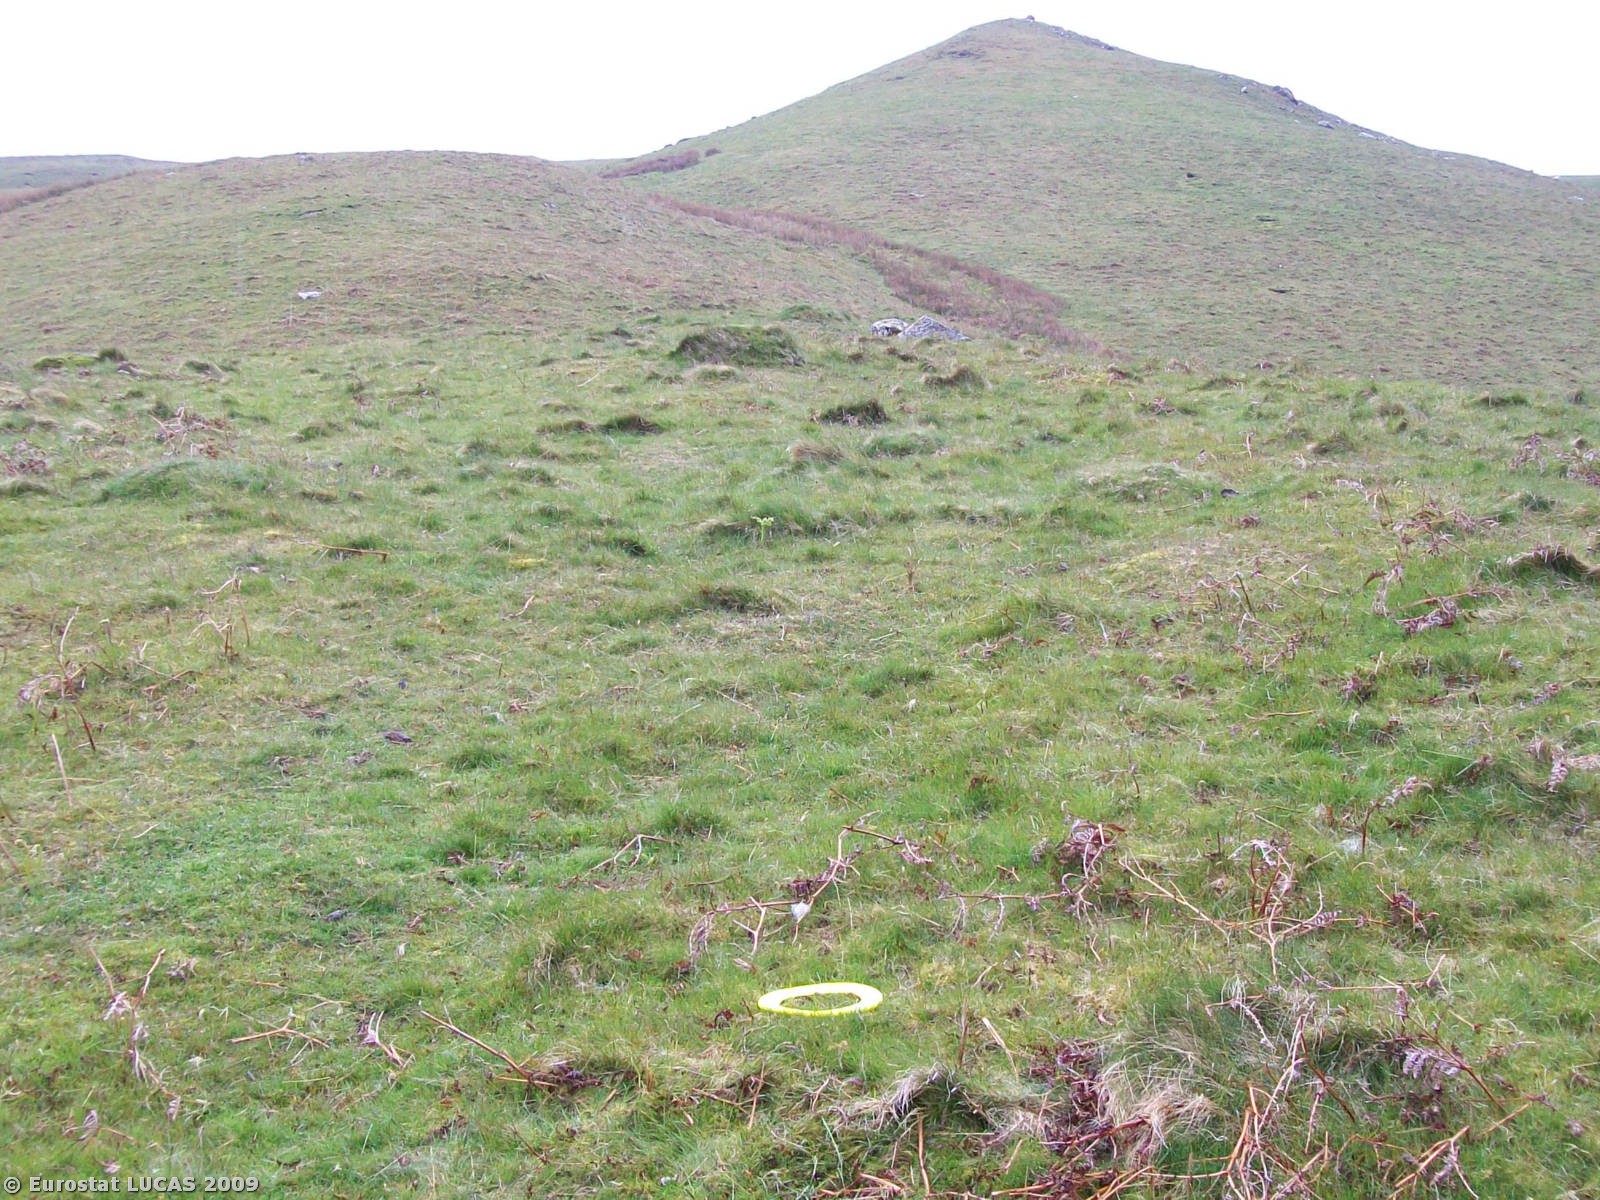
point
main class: Grassland
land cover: Grassland without tree/shrub cover
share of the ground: > 75 %
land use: Agriculture (excluding fallow land and kitchen gardens)
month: May
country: GB
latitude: 54.6862
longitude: -3.1515
